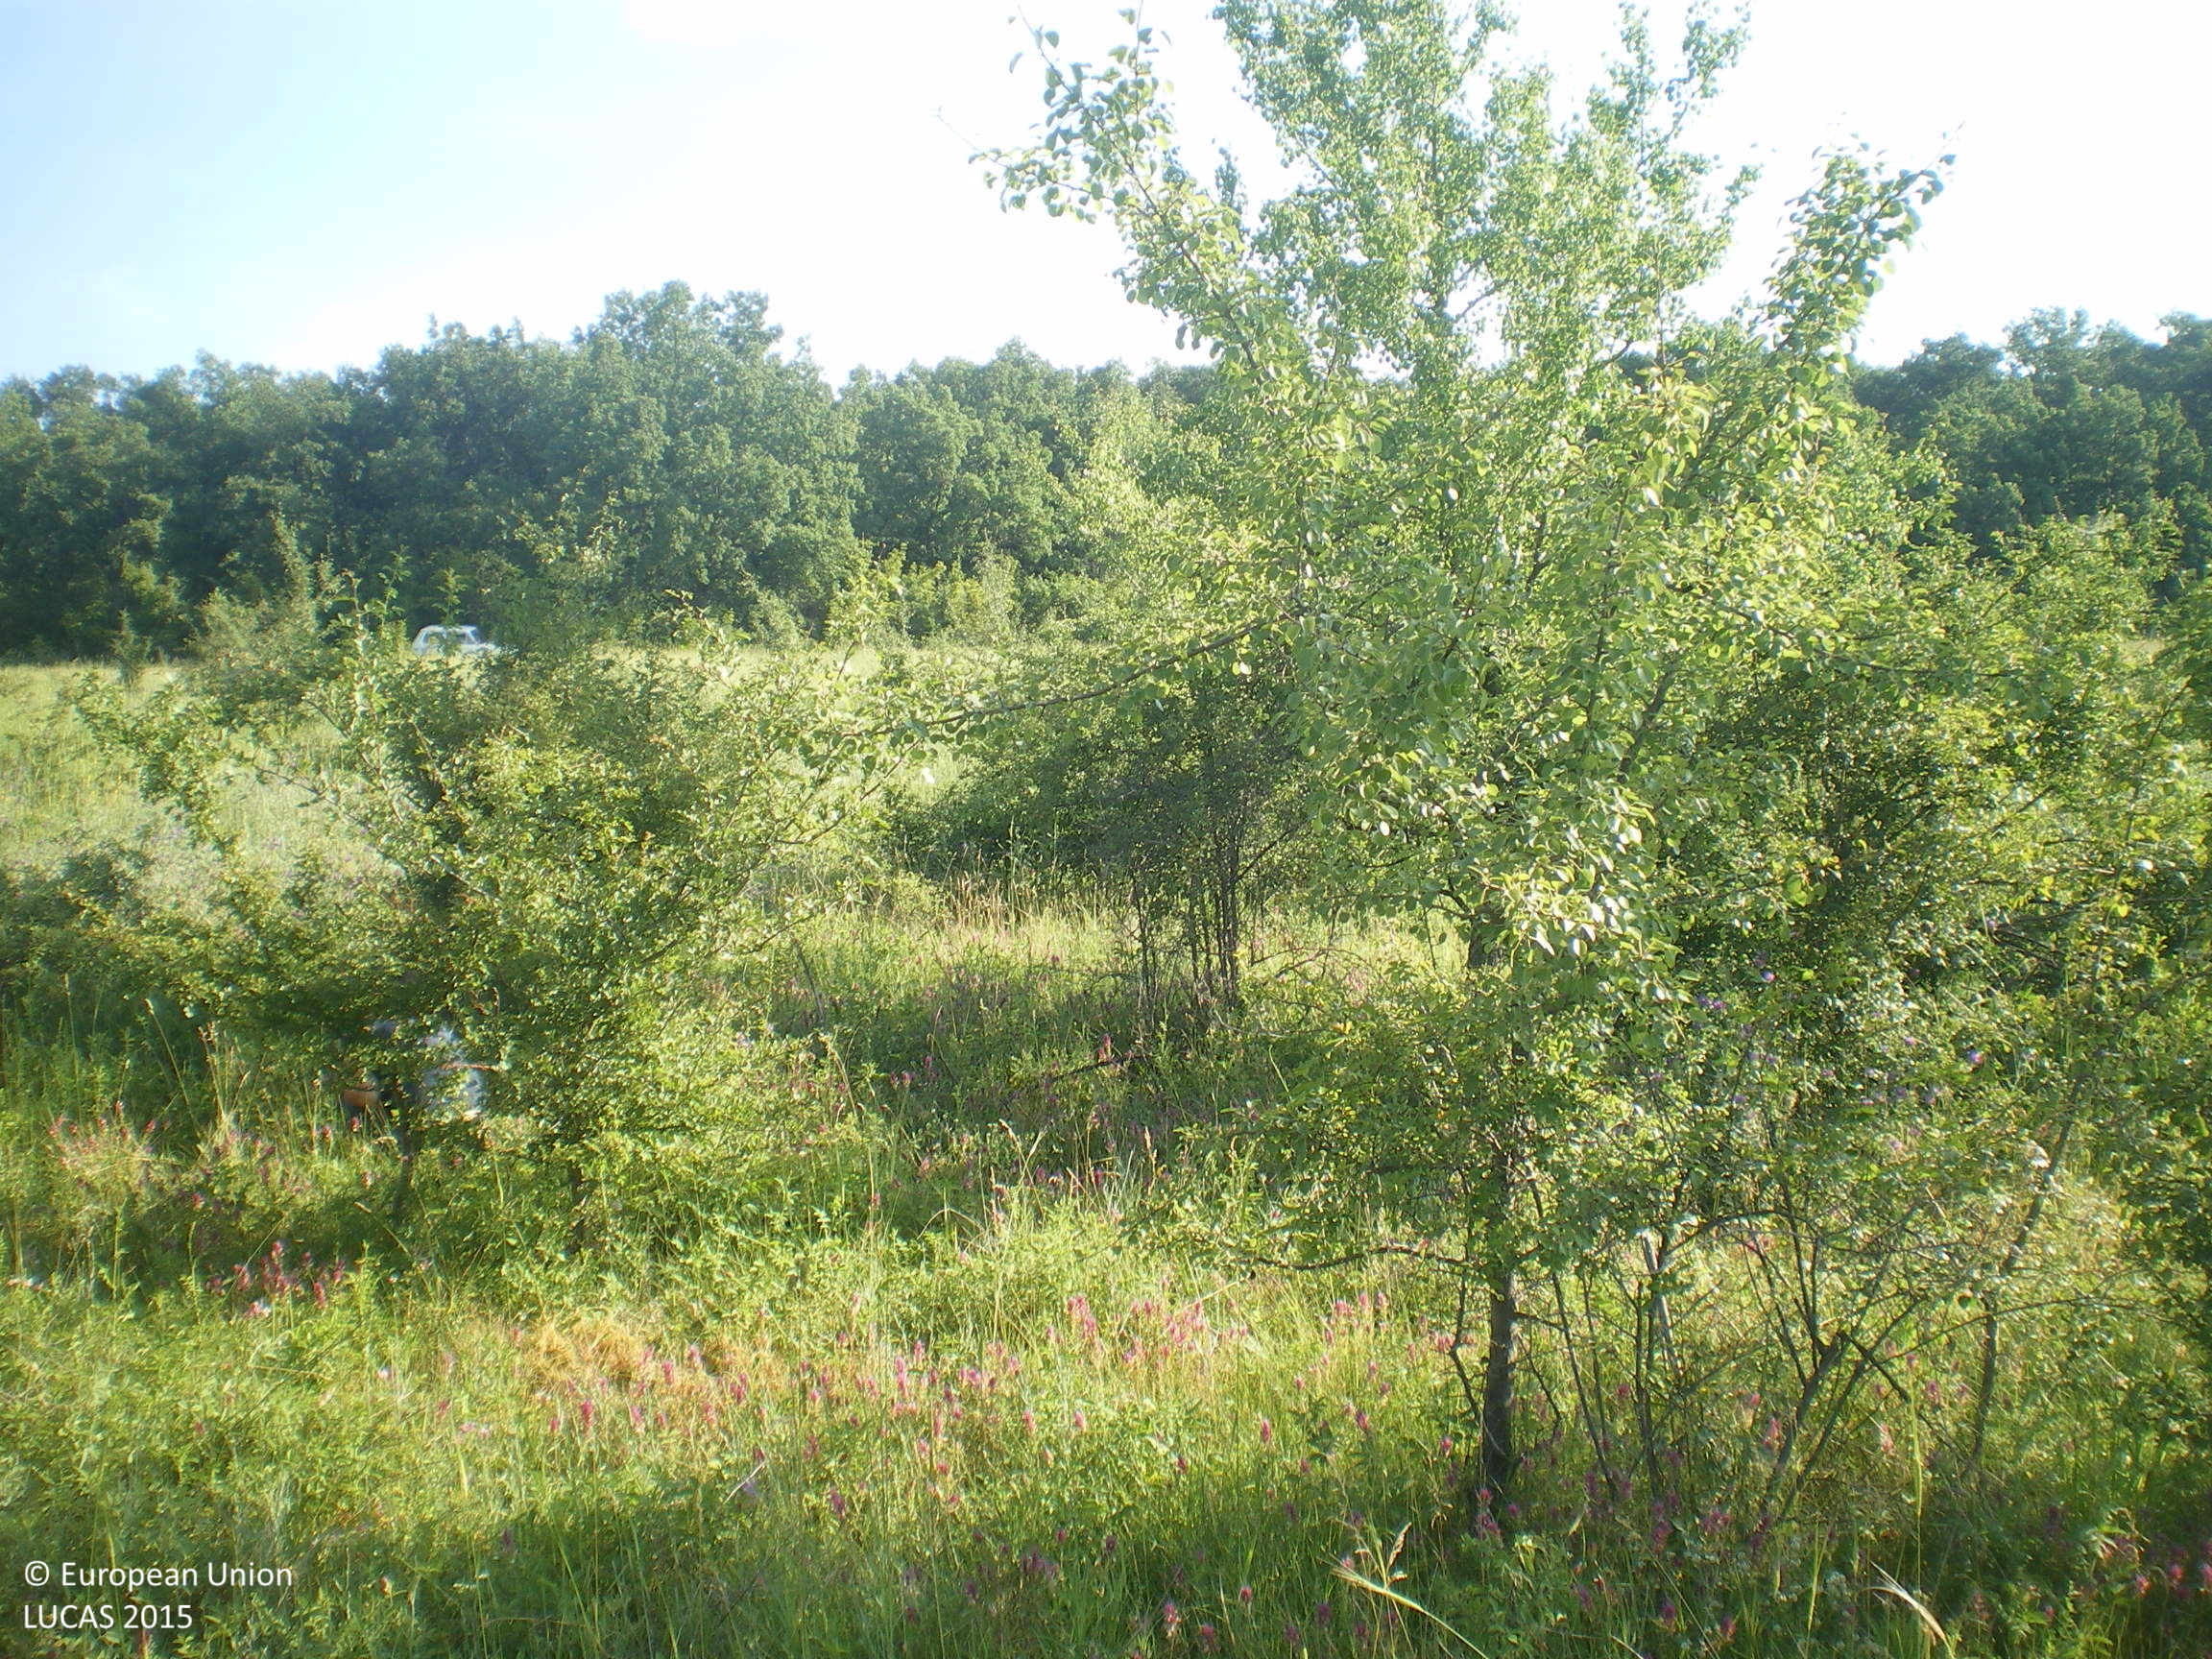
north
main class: Grassland
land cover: Grassland with sparse tree/shrub cover
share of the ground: > 75 %
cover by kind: herbaceous plants 90 %, broadleaved forest trees 5 %, shrubs 5 %
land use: Forestry
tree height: < 5 m
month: June
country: BG
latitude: 42.3929
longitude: 25.1123
